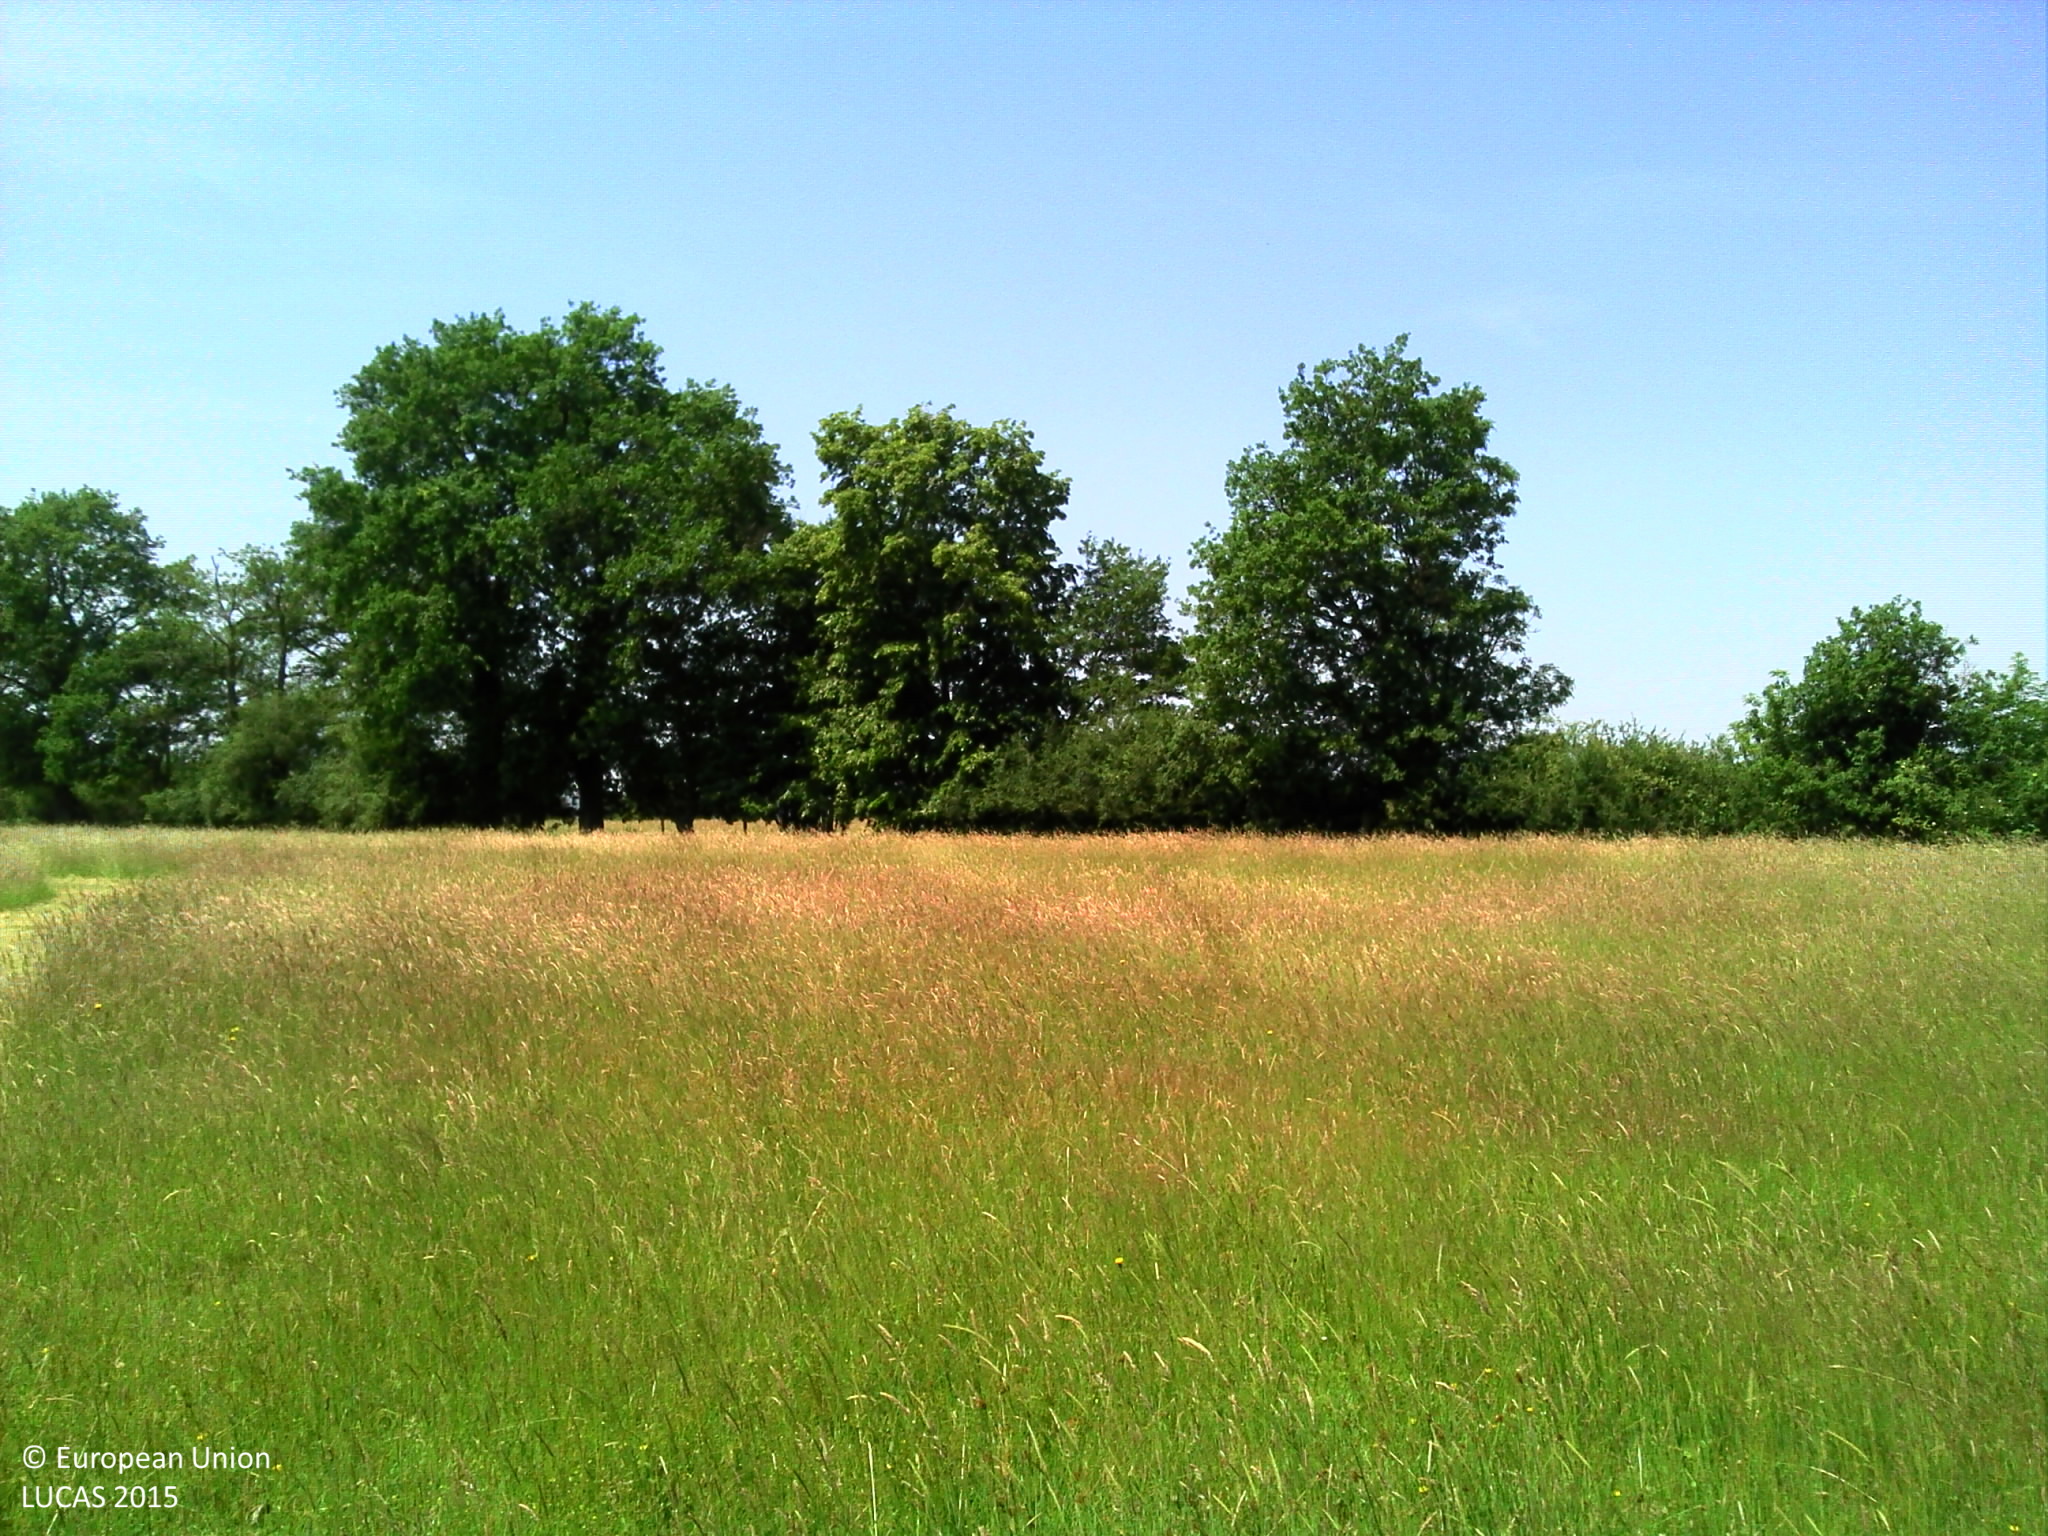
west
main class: Grassland
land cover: Grassland without tree/shrub cover
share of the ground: > 75 %
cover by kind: herbaceous plants 100 %
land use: Agriculture (excluding fallow land and kitchen gardens)
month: June
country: FR
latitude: 46.2888
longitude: 2.7930
